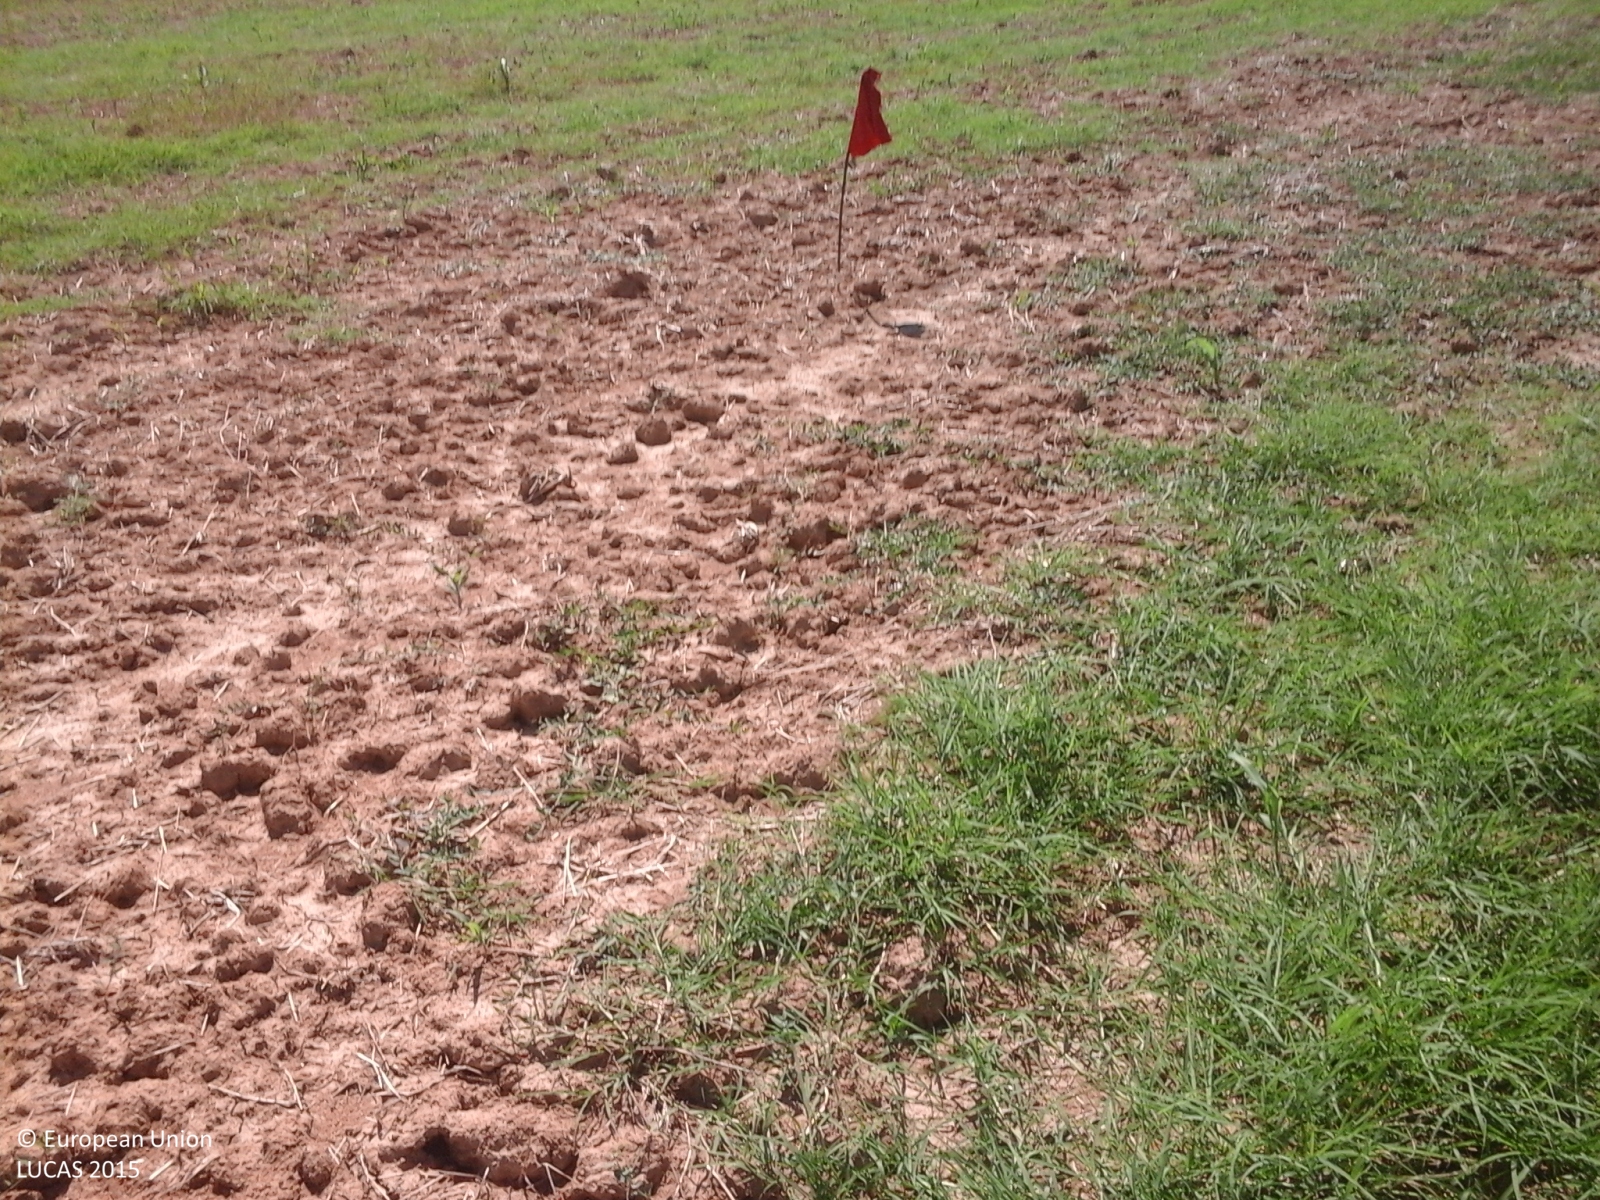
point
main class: Grassland
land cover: Grassland without tree/shrub cover
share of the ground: 50 - 75 %
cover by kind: herbaceous plants 65 %, unconsolidated bare surface 35 %
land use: Agriculture (excluding fallow land and kitchen gardens)
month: June
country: IT
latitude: 45.0444
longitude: 8.5934
